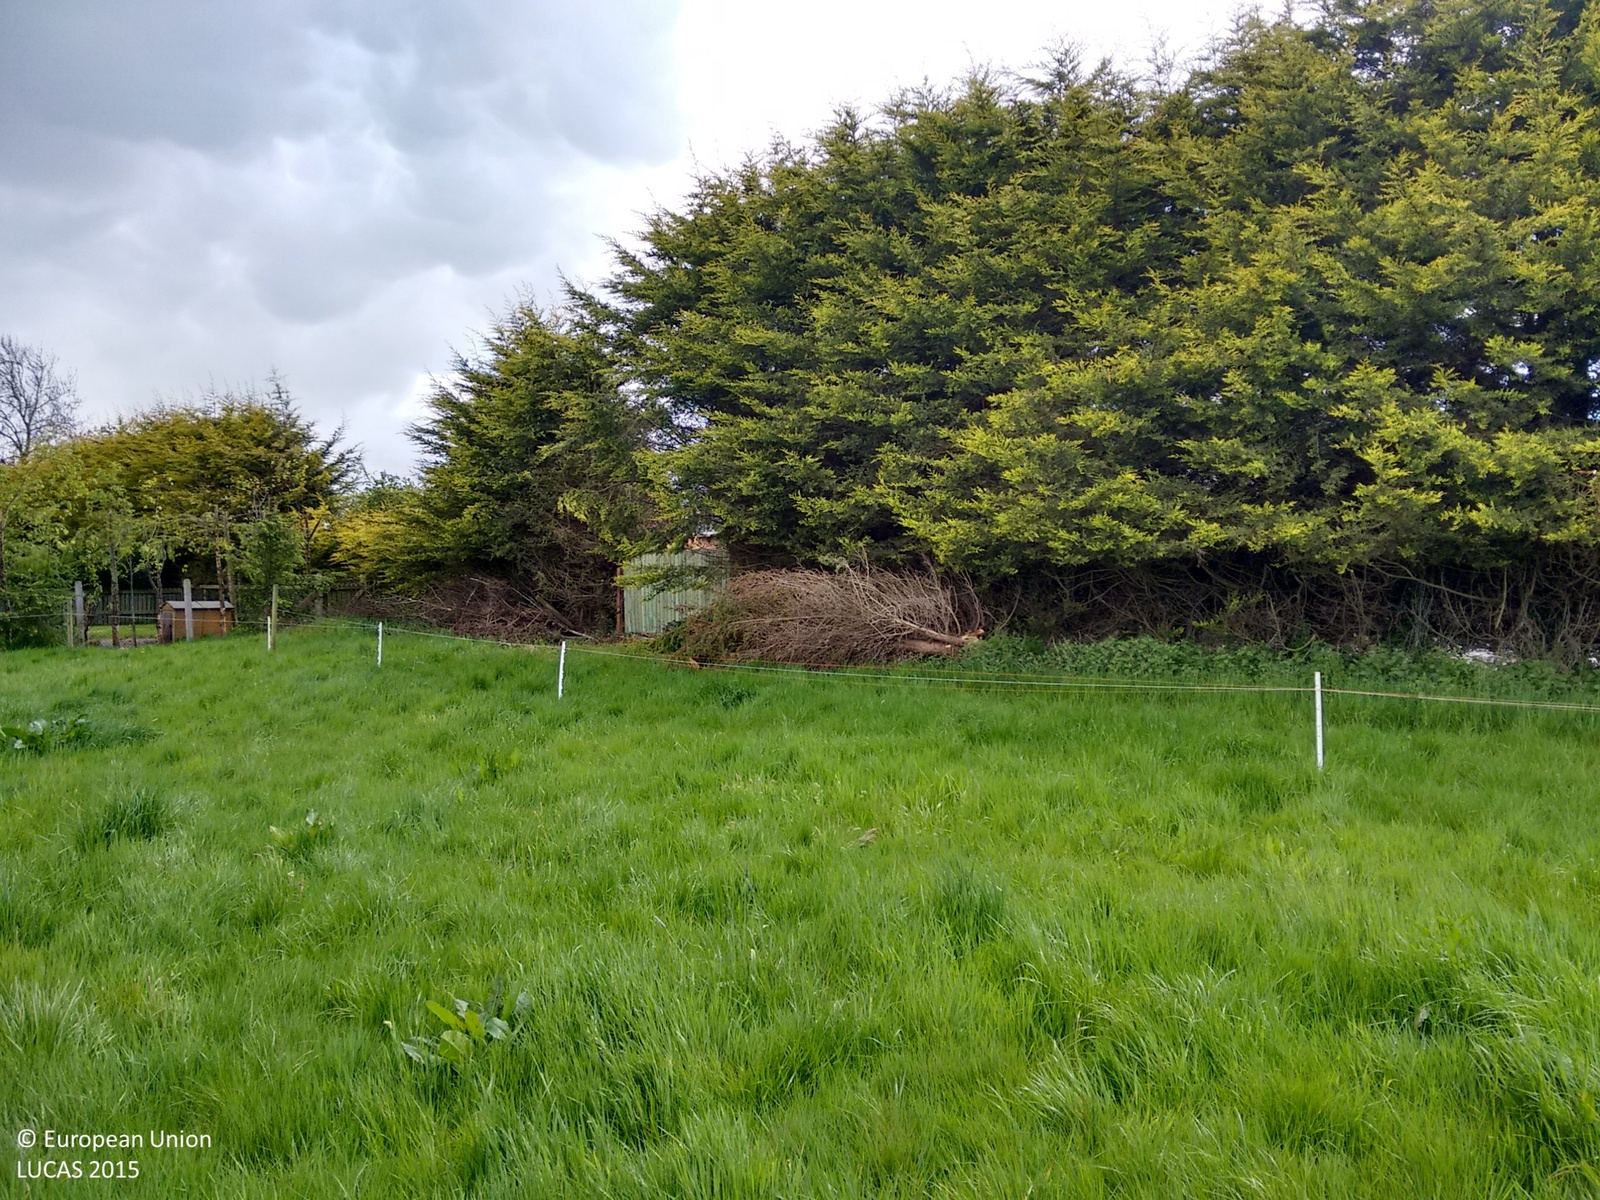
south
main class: Grassland
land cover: Grassland without tree/shrub cover
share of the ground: > 75 %
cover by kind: herbaceous plants 100 %
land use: Agriculture (excluding fallow land and kitchen gardens)
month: May
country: IE
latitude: 53.3944
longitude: -6.6584
